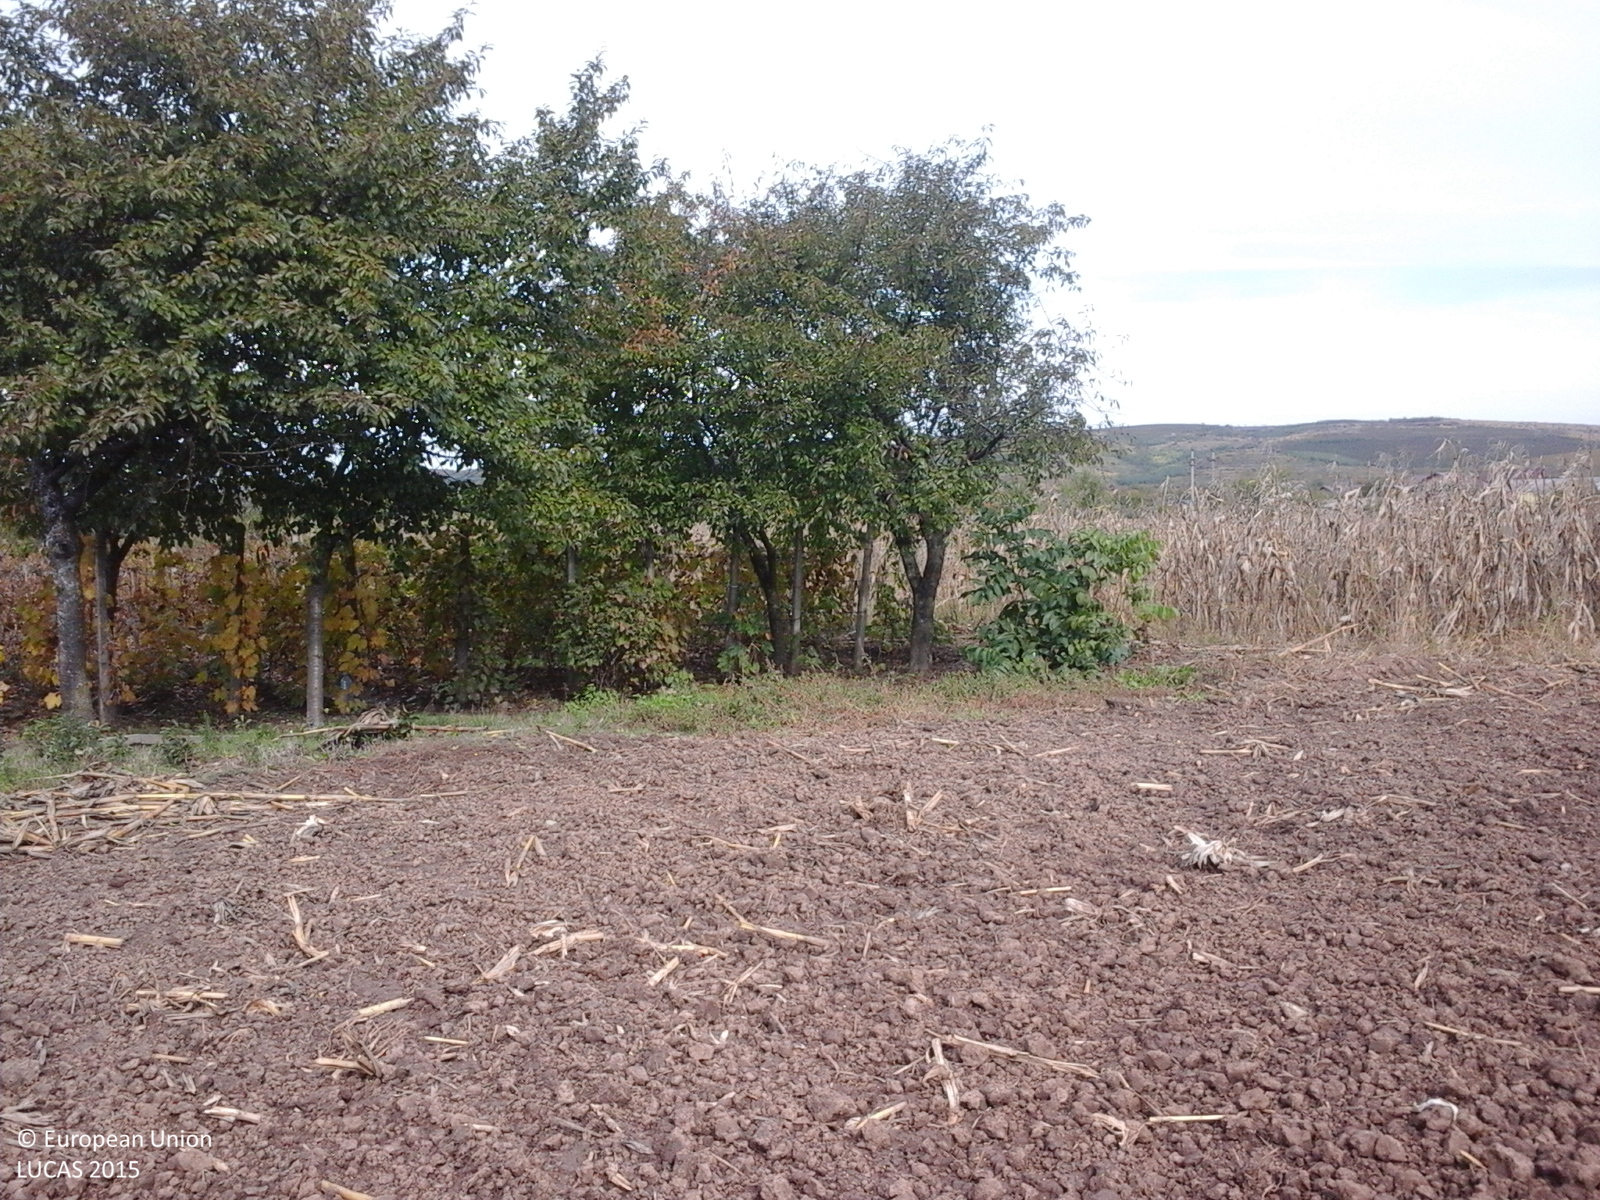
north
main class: Cropland
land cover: Maize
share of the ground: < 10 %
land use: Agriculture (excluding fallow land and kitchen gardens)
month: October
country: RO
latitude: 44.9998
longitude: 26.0556
